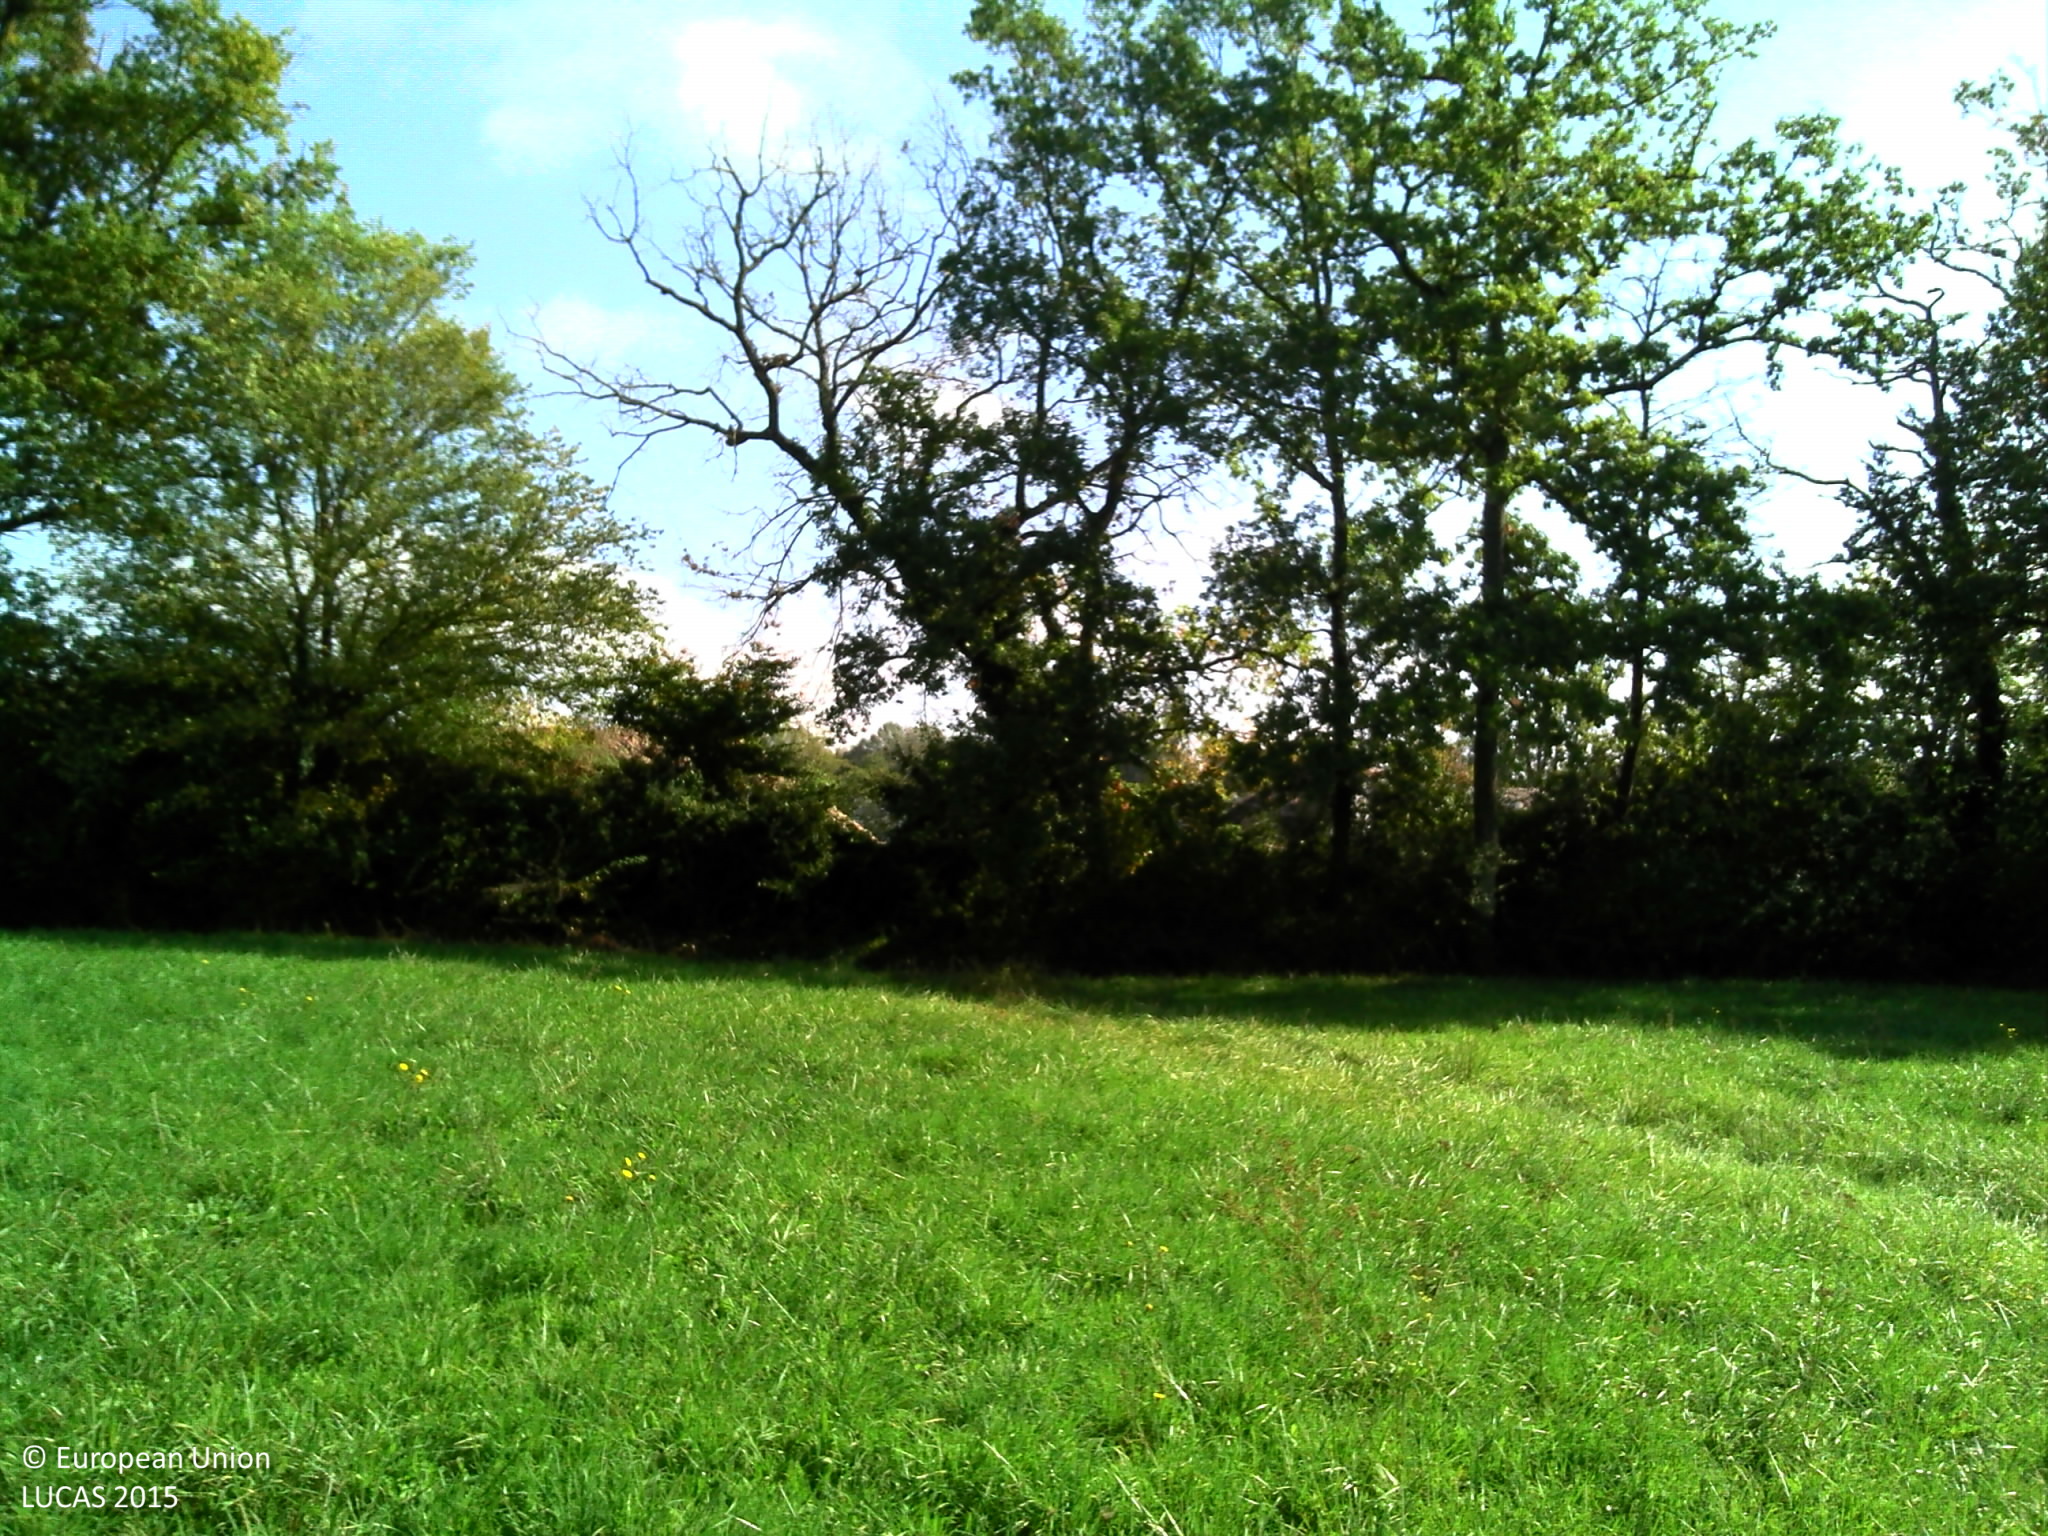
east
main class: Grassland
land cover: Grassland without tree/shrub cover
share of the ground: > 75 %
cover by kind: herbaceous plants 100 %
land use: Agriculture (excluding fallow land and kitchen gardens)
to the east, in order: Grassland without tree/shrub cover; Fences; Broadleaved woodland; Artificial constructions in urban areas; Grassland without tree/shrub cover
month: October
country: FR
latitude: 46.2838
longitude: 4.9017
